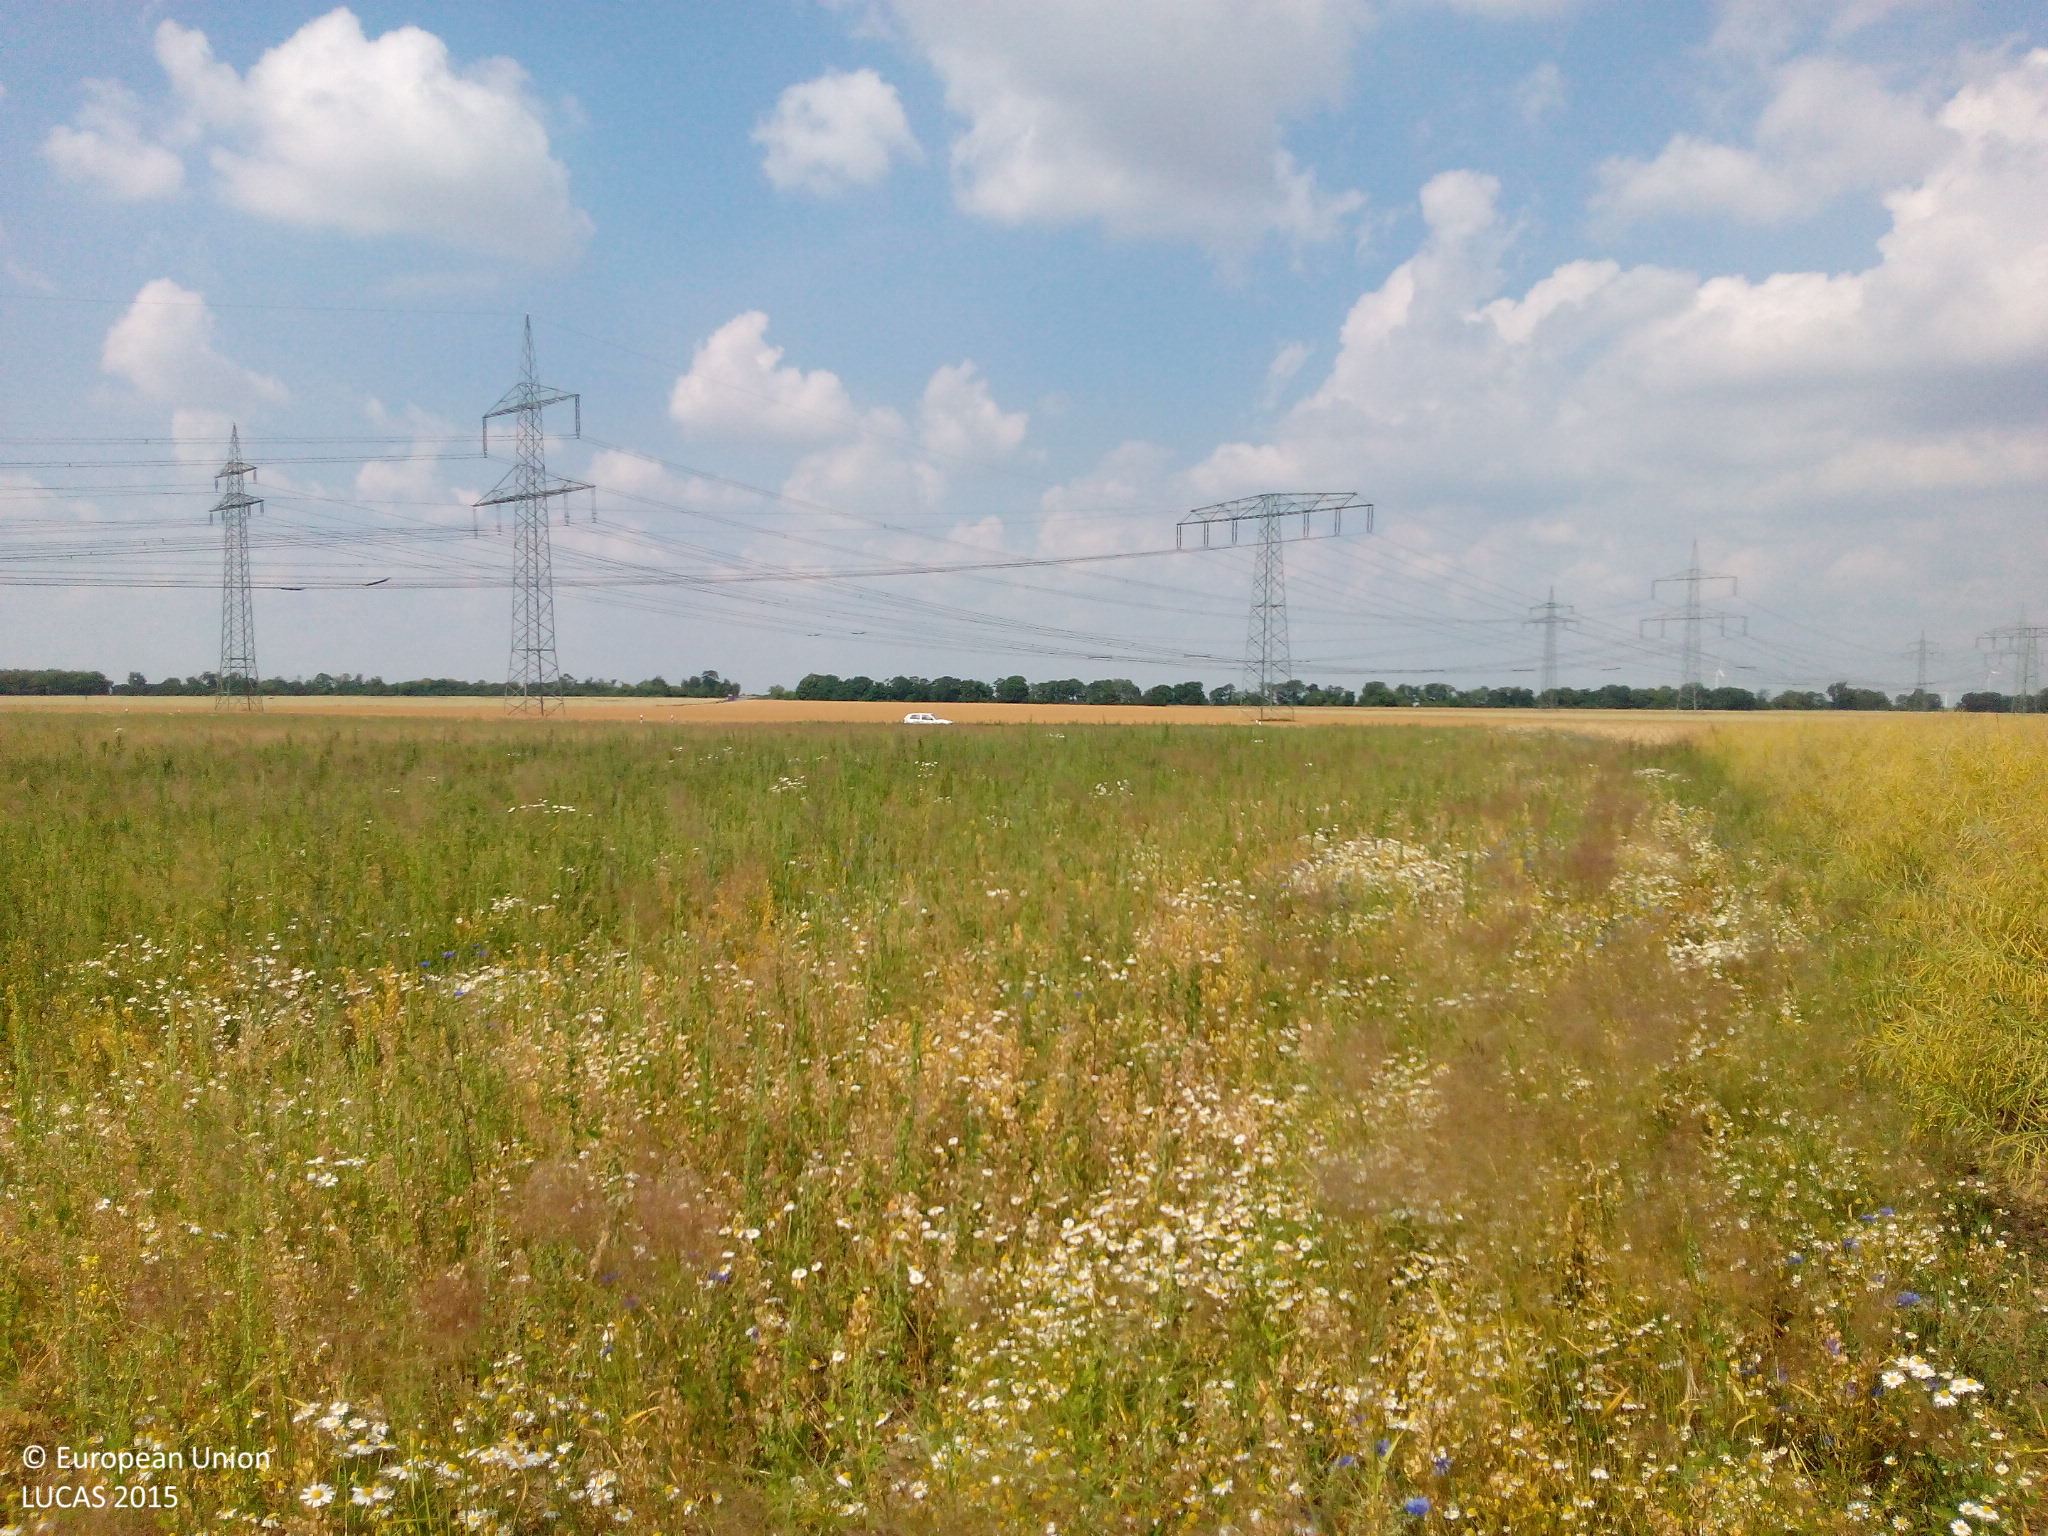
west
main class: Grassland
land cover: Grassland without tree/shrub cover
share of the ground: > 75 %
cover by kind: herbaceous plants 100 %
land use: Agriculture (excluding fallow land and kitchen gardens)
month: June
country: DE
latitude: 51.3204
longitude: 13.4298
